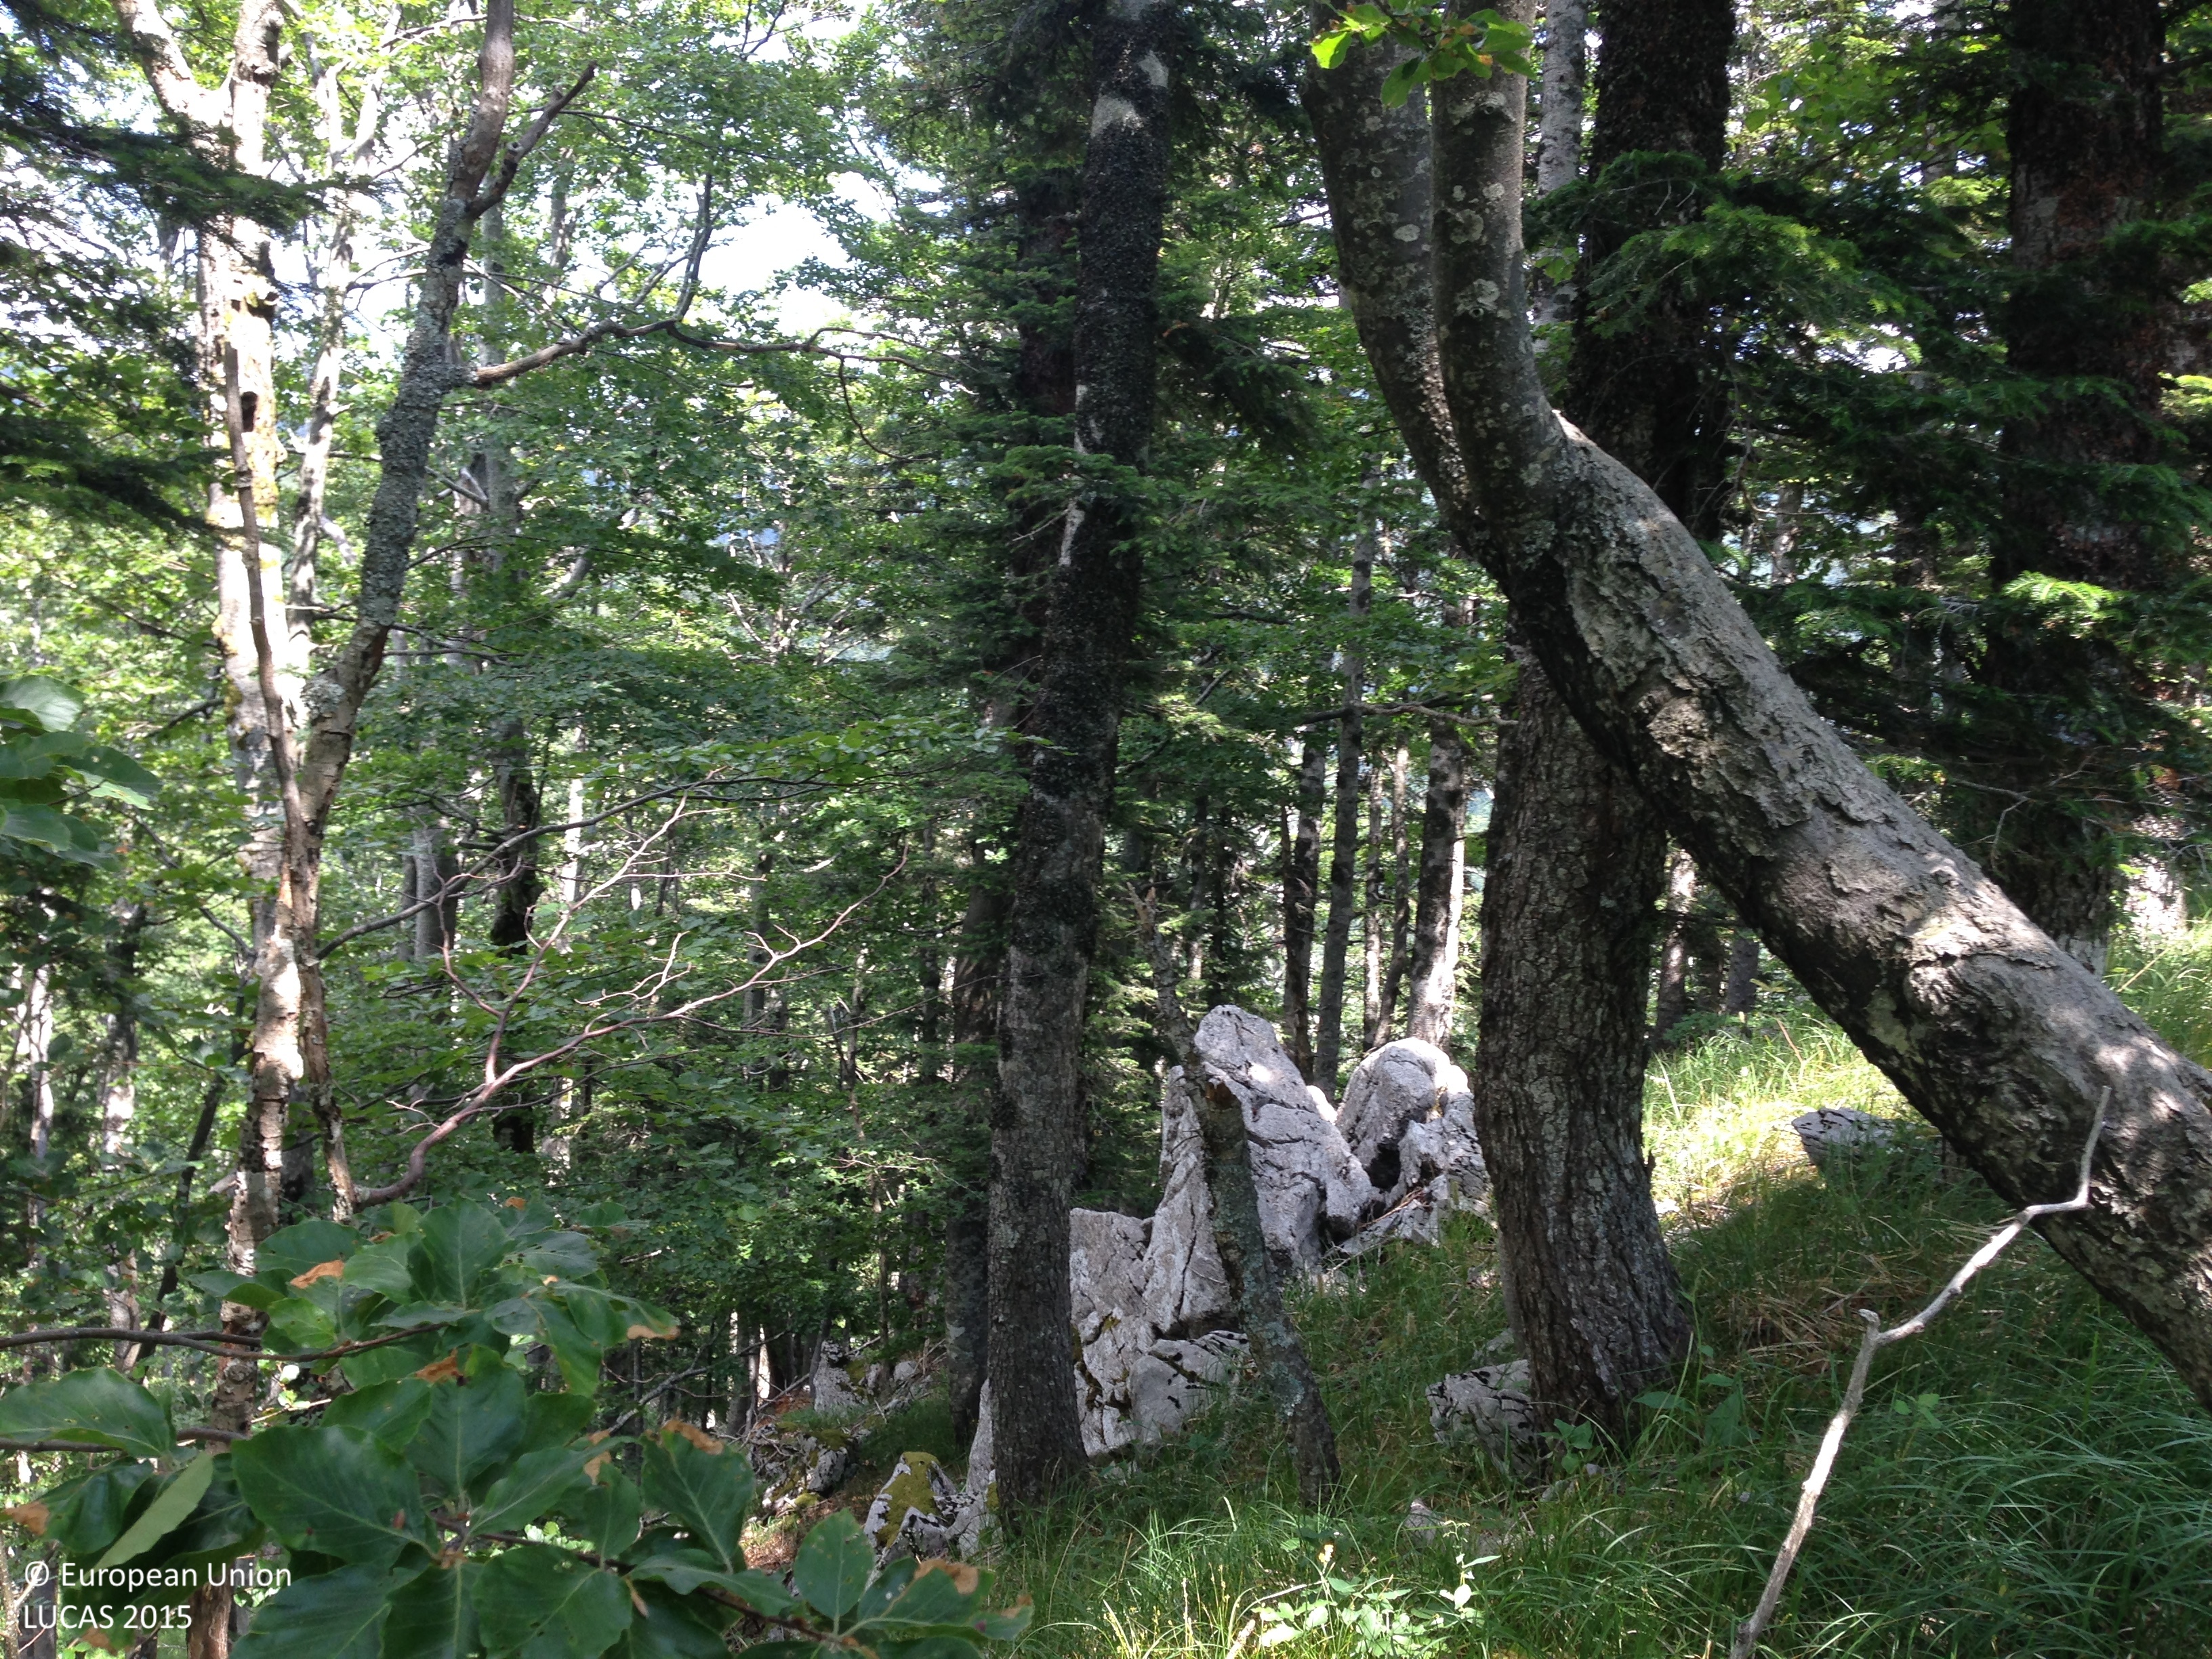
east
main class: Woodland
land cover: Other mixed woodland
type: thermophilous deciduous forest
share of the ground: > 75 %
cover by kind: broadleaved forest trees 40 %, coniferous forest trees 20 %, herbaceous plants 20 %, consolidated bare surface 10 %, shrubs 5 %, unconsolidated bare surface 5 %
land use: Forestry
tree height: > 5 m
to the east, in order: Other mixed woodland; Tracks; Other mixed woodland
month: July
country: HR
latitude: 44.6240
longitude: 15.0727
